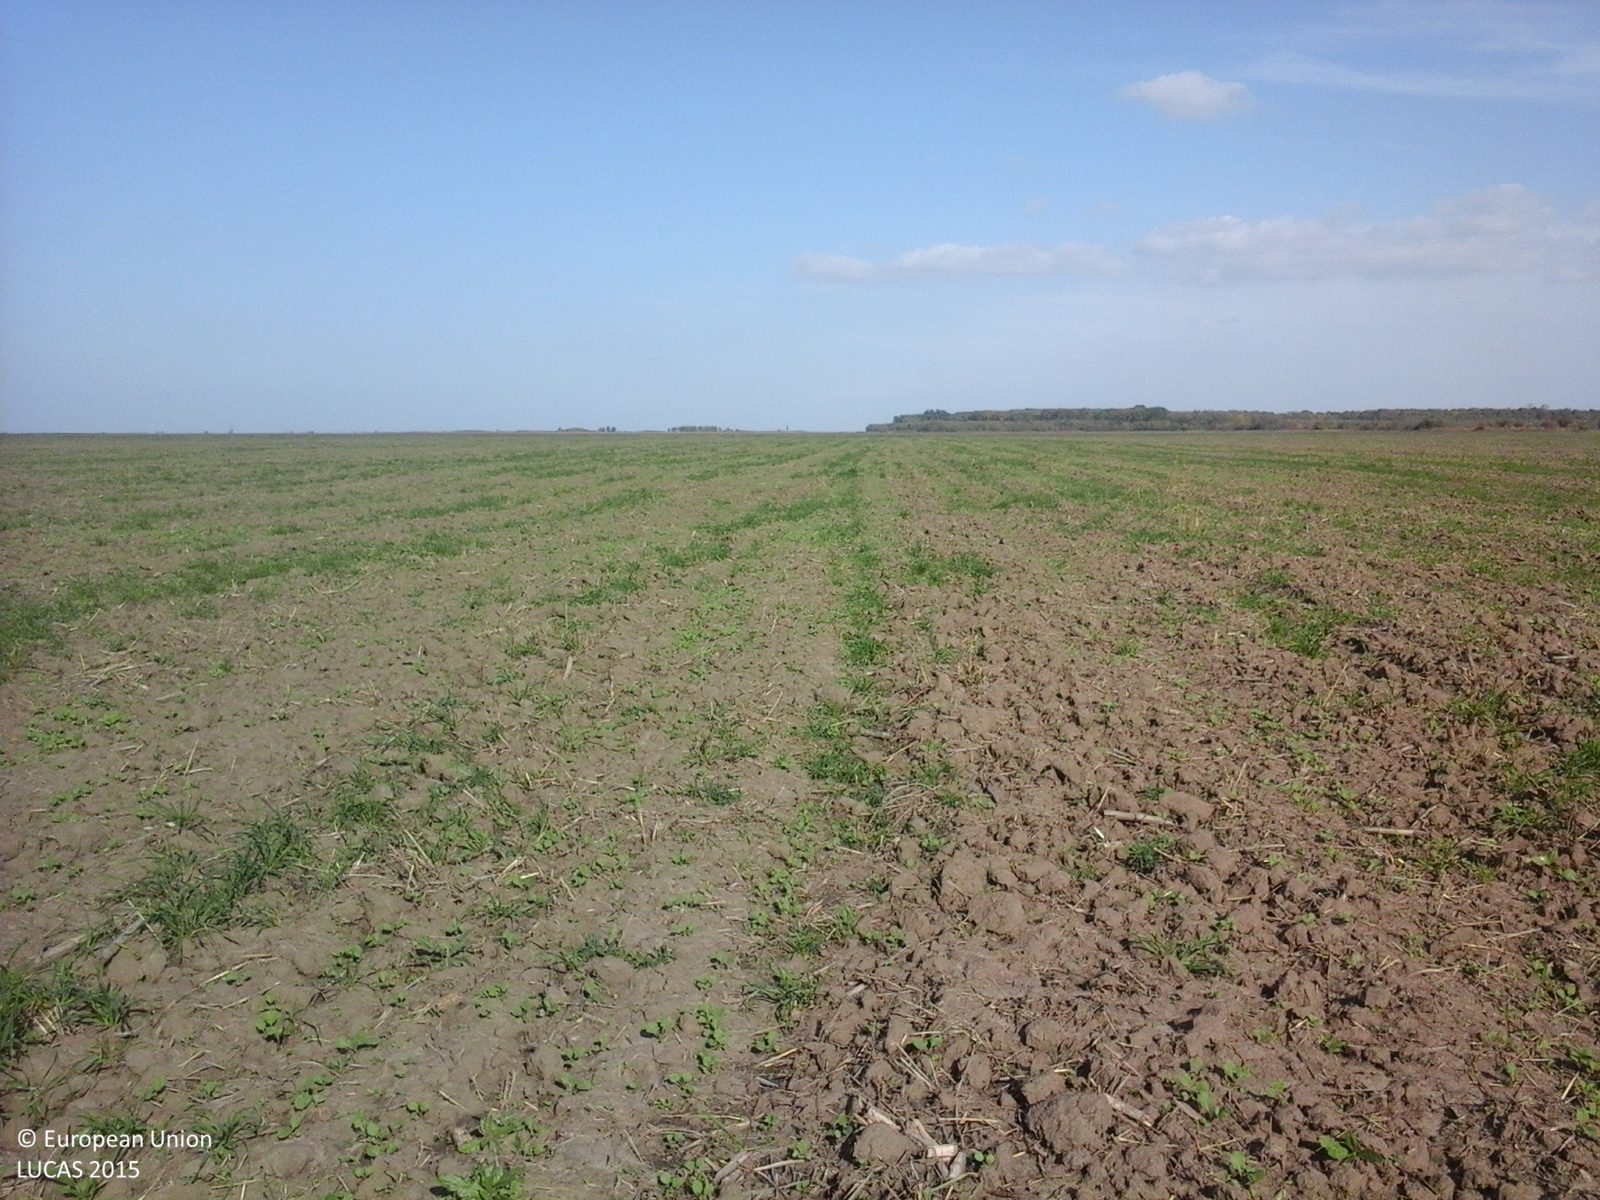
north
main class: Cropland
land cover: Rape and turnip rape
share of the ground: 10 - 25 %
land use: Agriculture (excluding fallow land and kitchen gardens)
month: October
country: RO
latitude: 45.3529
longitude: 27.2885
